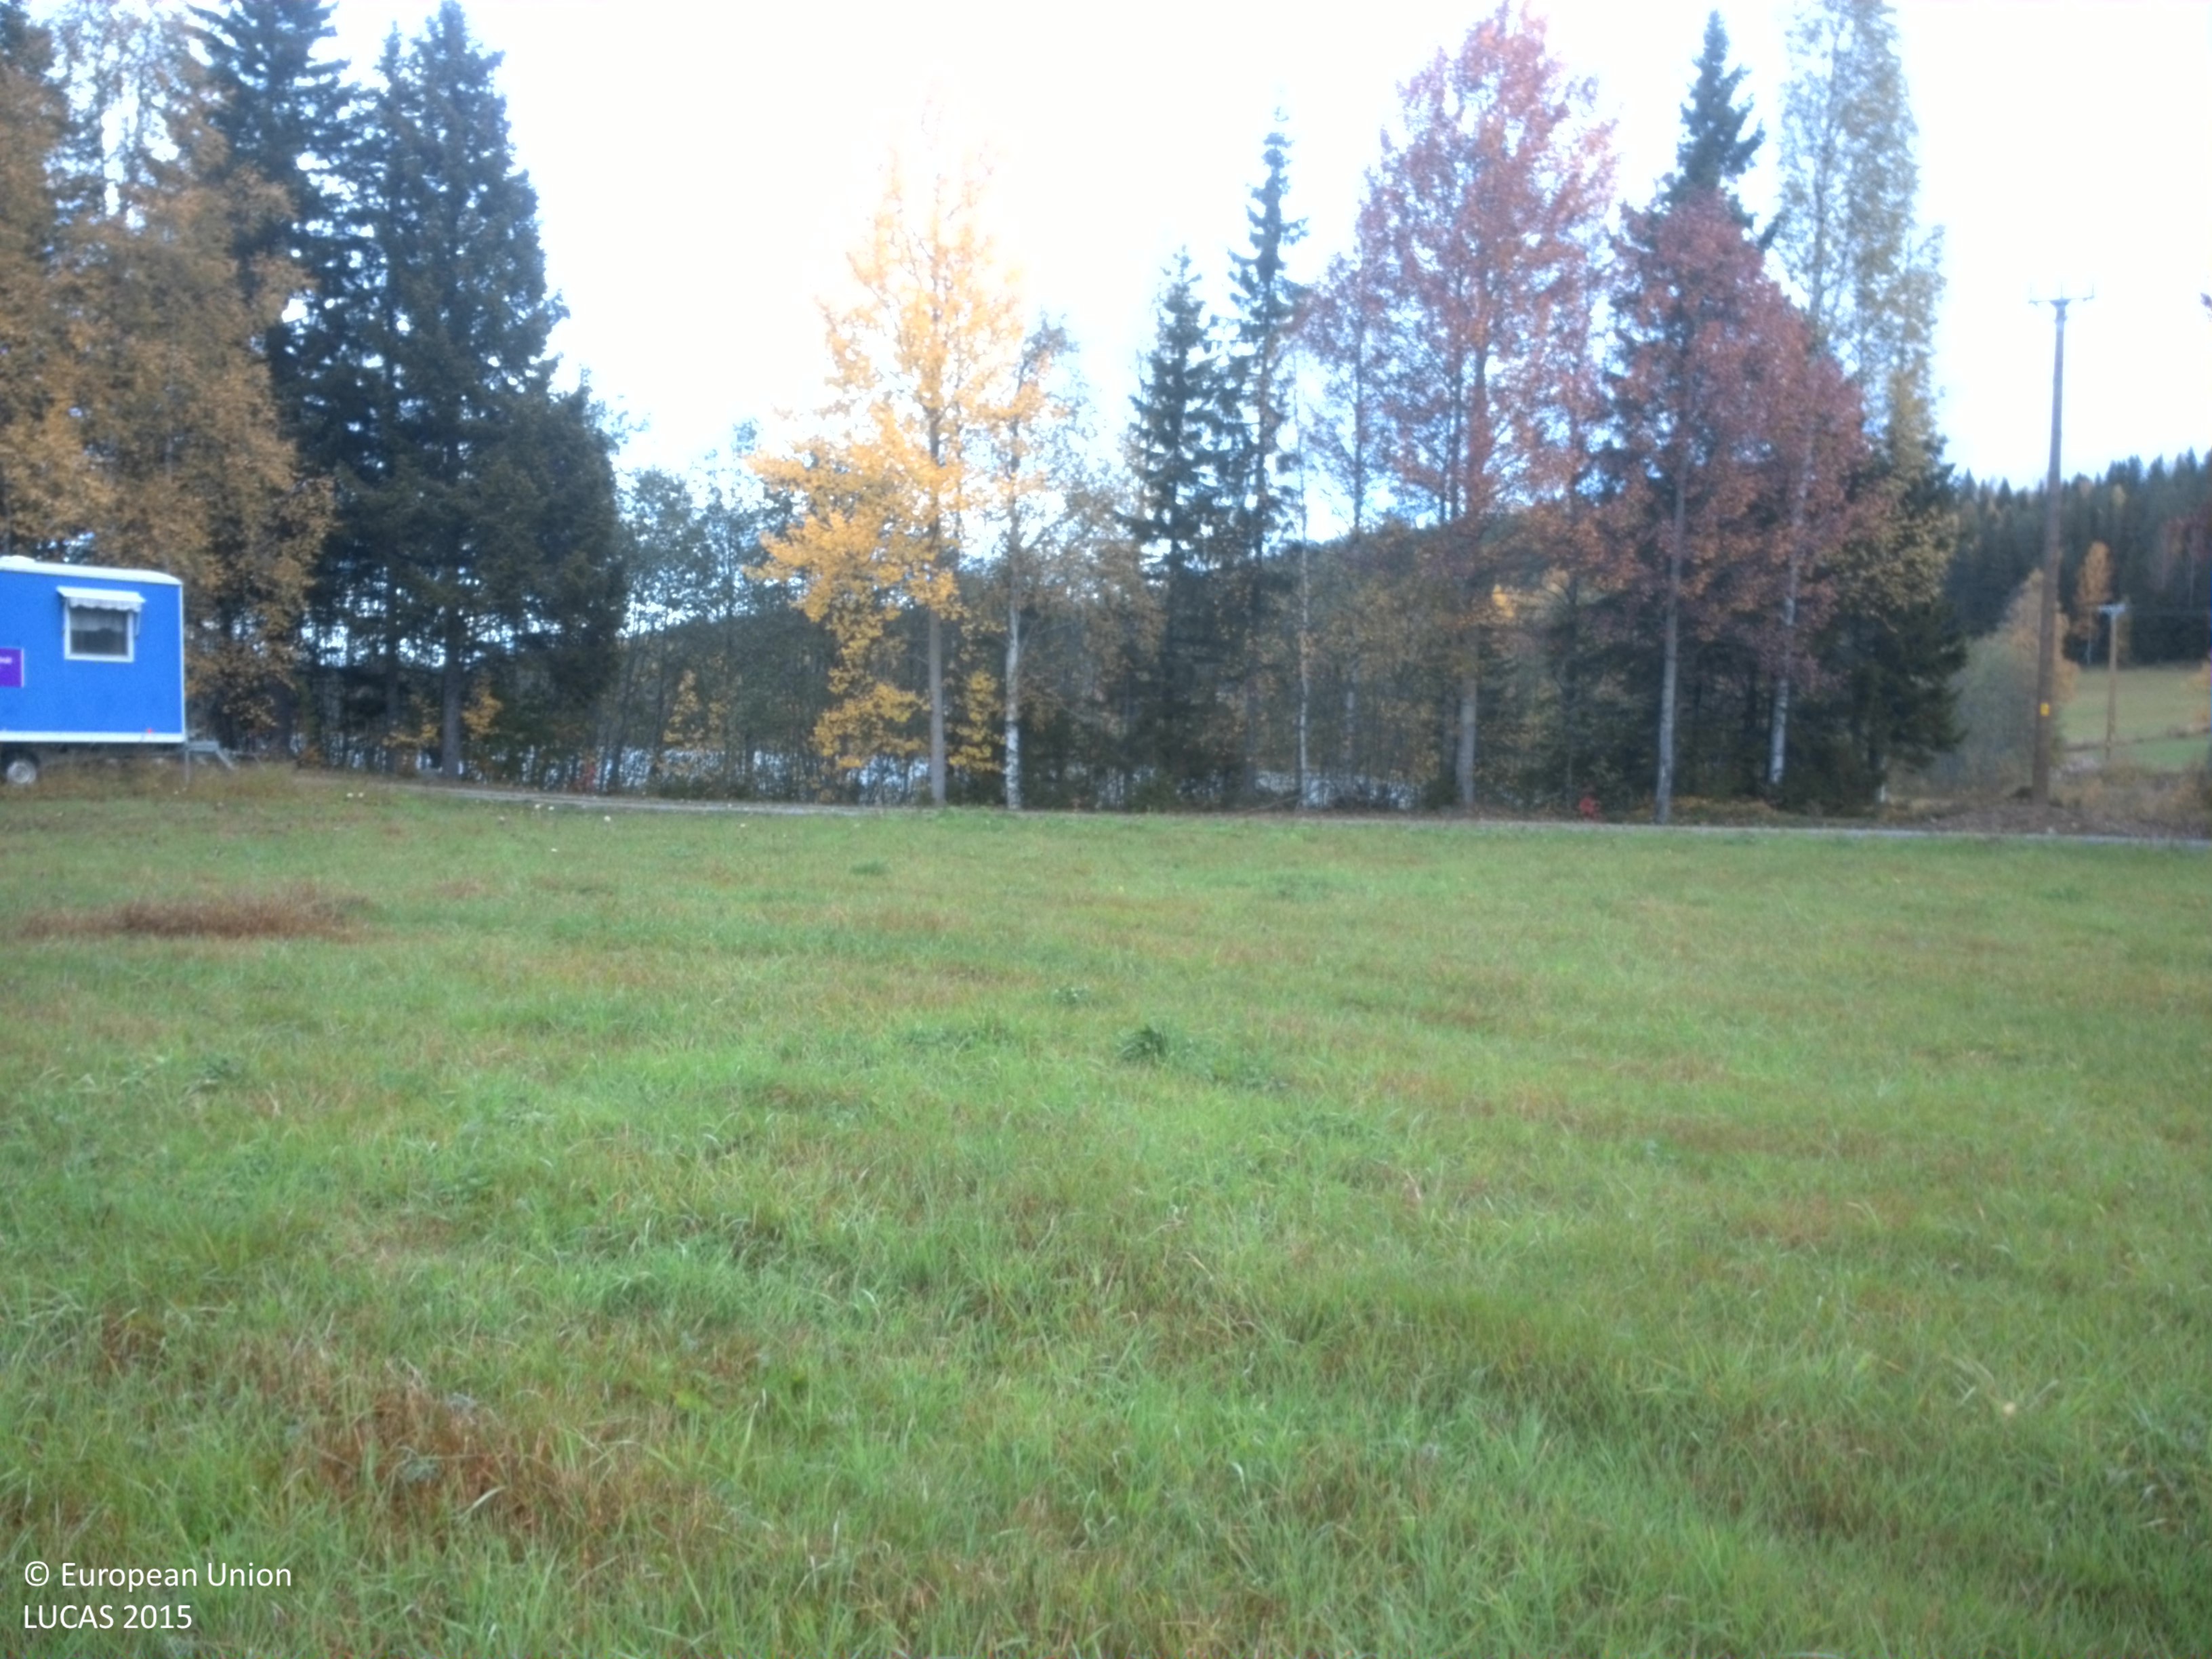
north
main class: Grassland
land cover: Grassland without tree/shrub cover
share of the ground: > 75 %
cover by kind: herbaceous plants 100 %
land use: Agriculture (excluding fallow land and kitchen gardens)
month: September
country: SE
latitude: 64.2293
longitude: 19.9746
